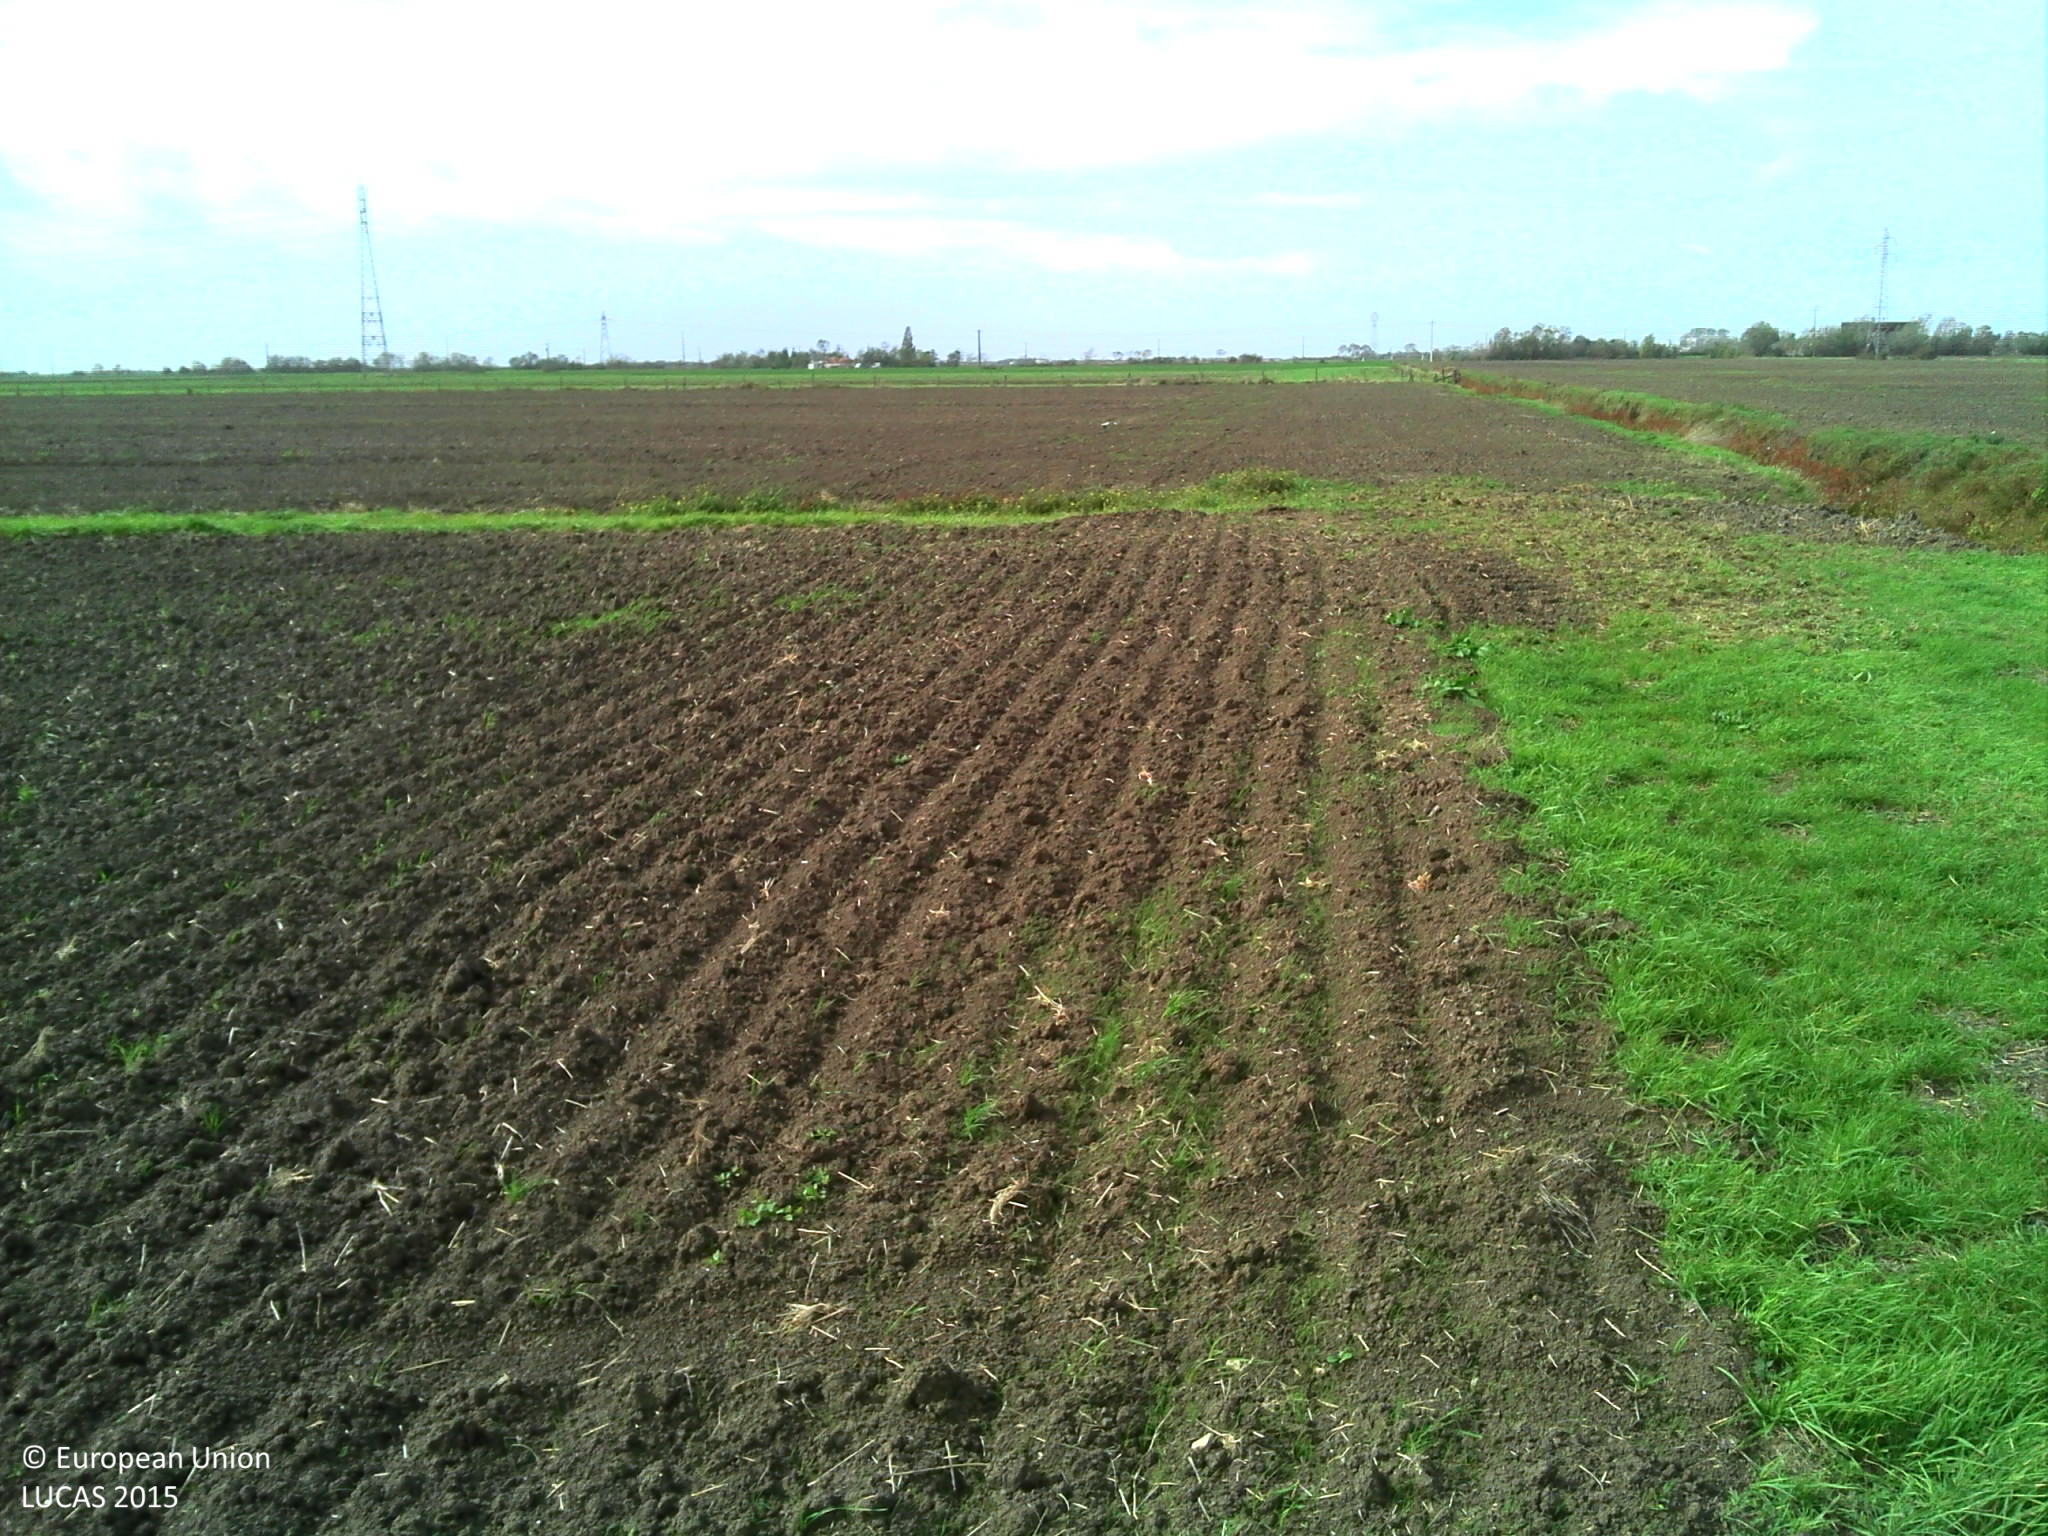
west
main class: Grassland
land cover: Grassland without tree/shrub cover
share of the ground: < 10 %
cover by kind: herbaceous plants 100 %
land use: Agriculture (excluding fallow land and kitchen gardens)
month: October
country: FR
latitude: 46.3718
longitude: -1.0951
